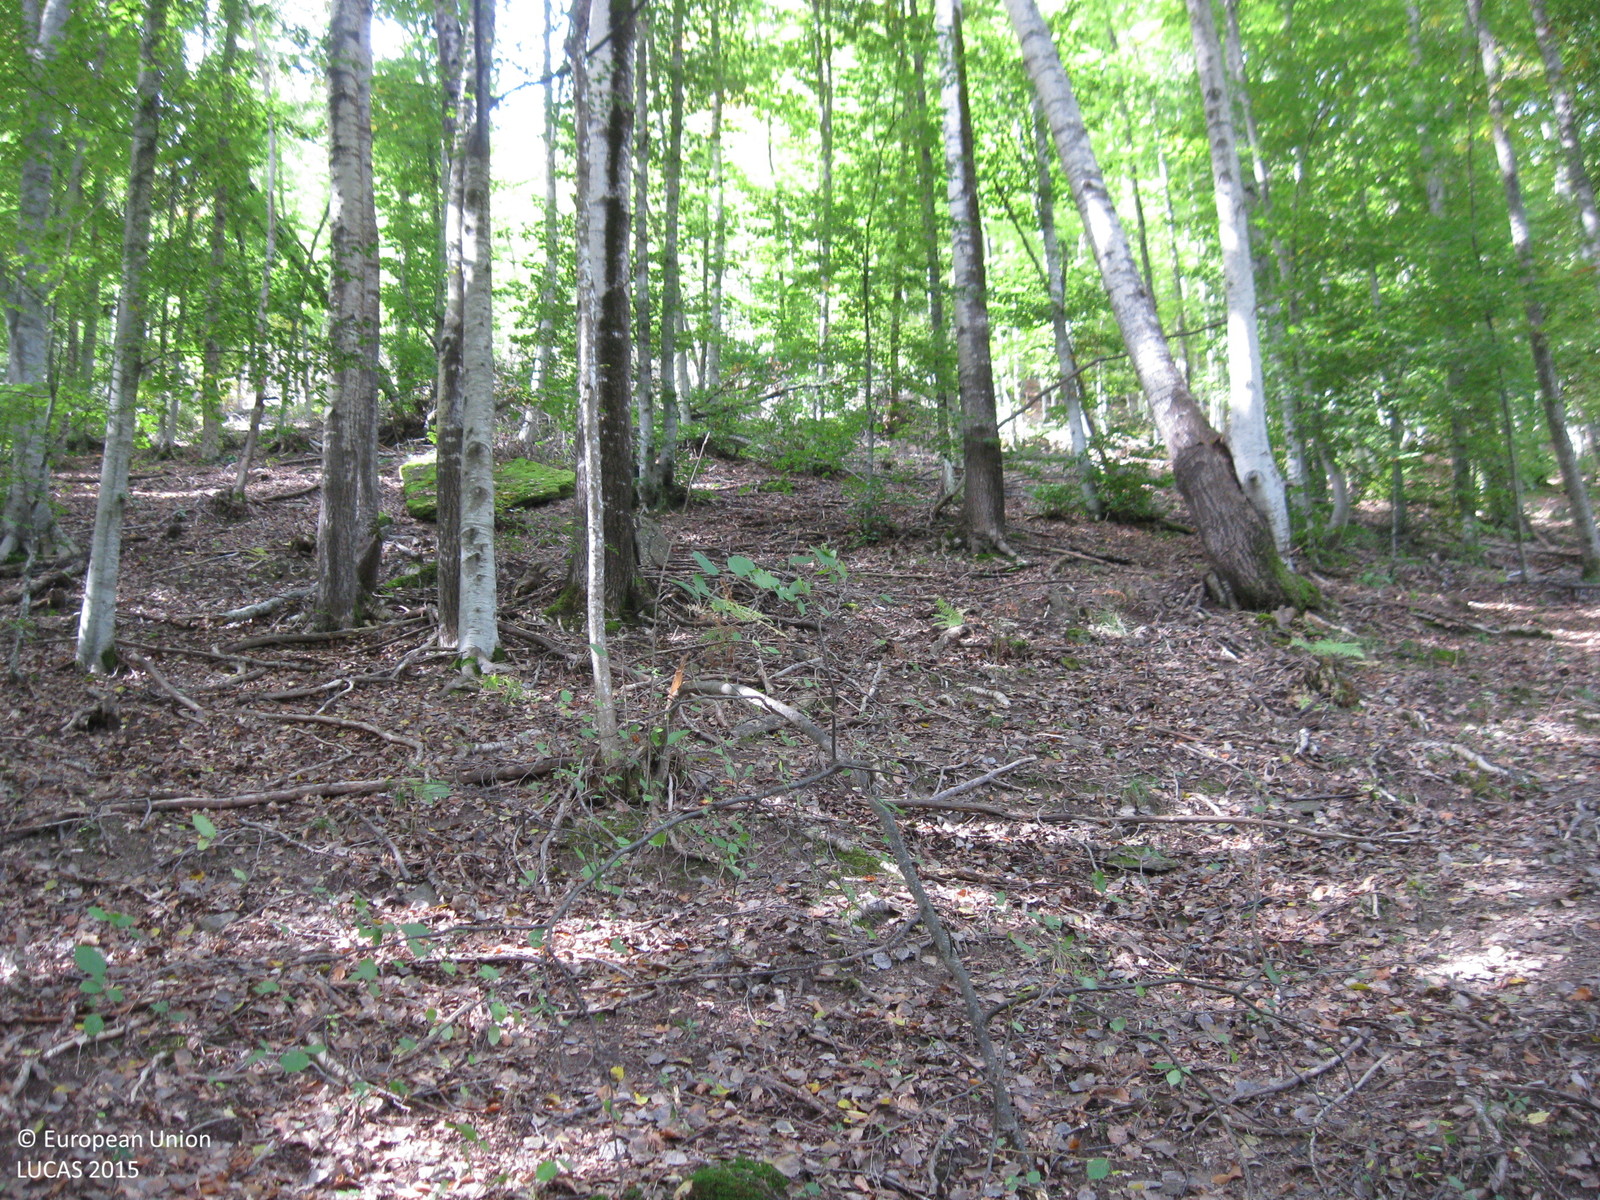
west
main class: Woodland
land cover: Broadleaved woodland
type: mountainous beech forest
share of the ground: > 75 %
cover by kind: broadleaved forest trees 90 %, shrubs 5 %, lichens and mosses 5 %
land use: Forestry
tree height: > 5 m
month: October
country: BG
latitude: 41.7782
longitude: 24.9328
